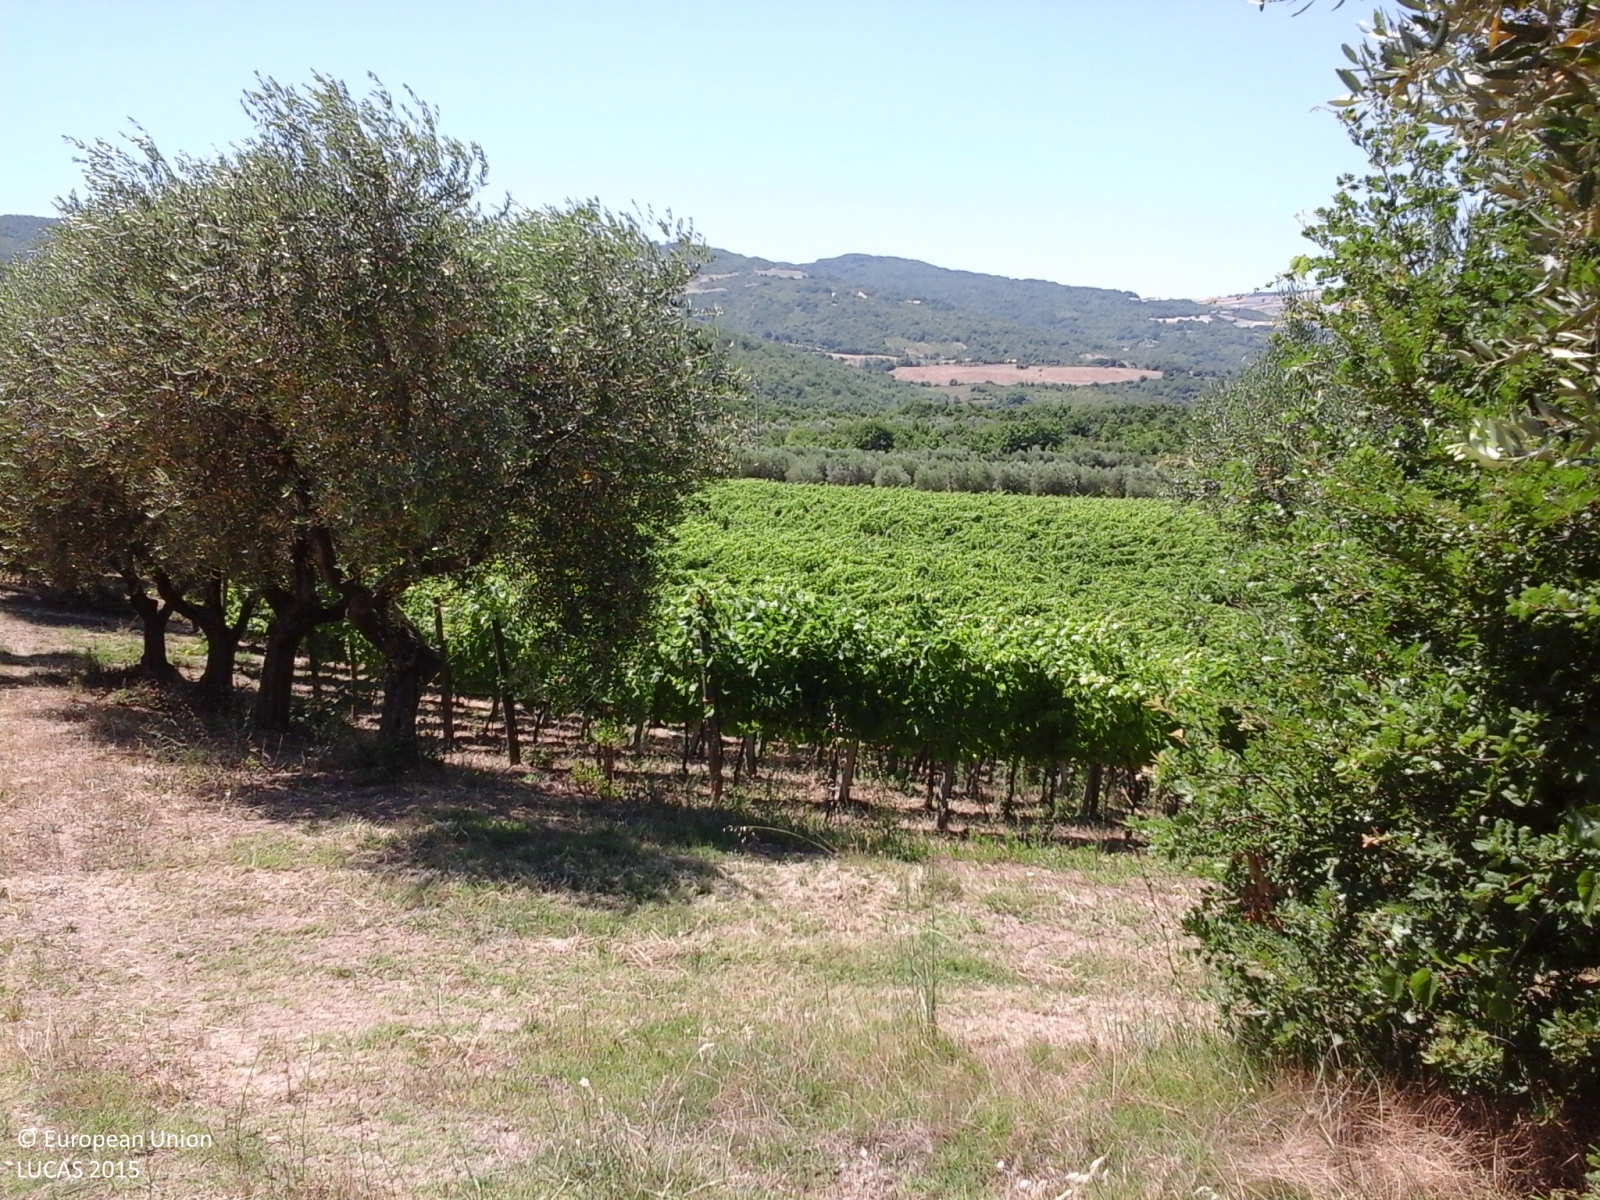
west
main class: Cropland
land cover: Olive groves
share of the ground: 25 - 50 %
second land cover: Spontaneously vegetated surfaces
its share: > 75 %
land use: Agriculture (excluding fallow land and kitchen gardens)
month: July
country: IT
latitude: 41.7133
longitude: 14.6837
